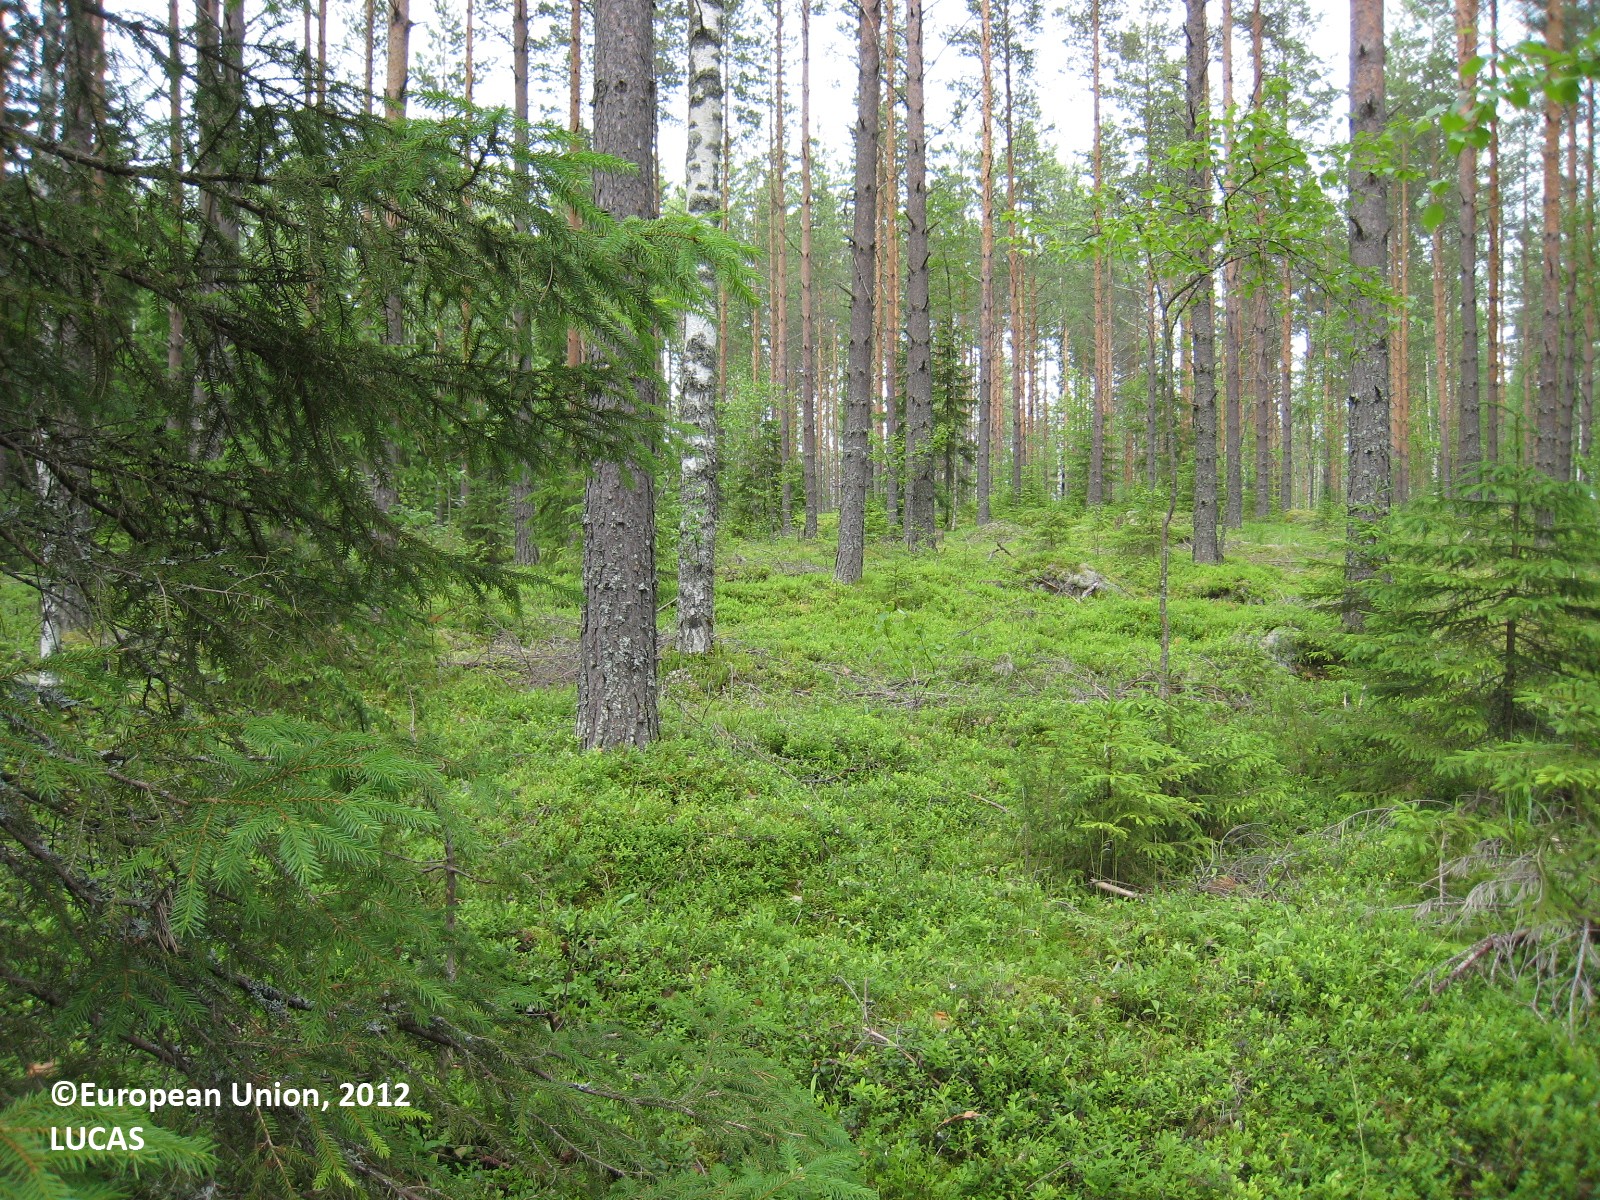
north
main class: Woodland
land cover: Pine dominated coniferous woodland
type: boreal forest
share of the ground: 25 - 50 %
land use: Forestry
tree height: > 5 m
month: June
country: FI
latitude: 62.0130
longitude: 26.2775
